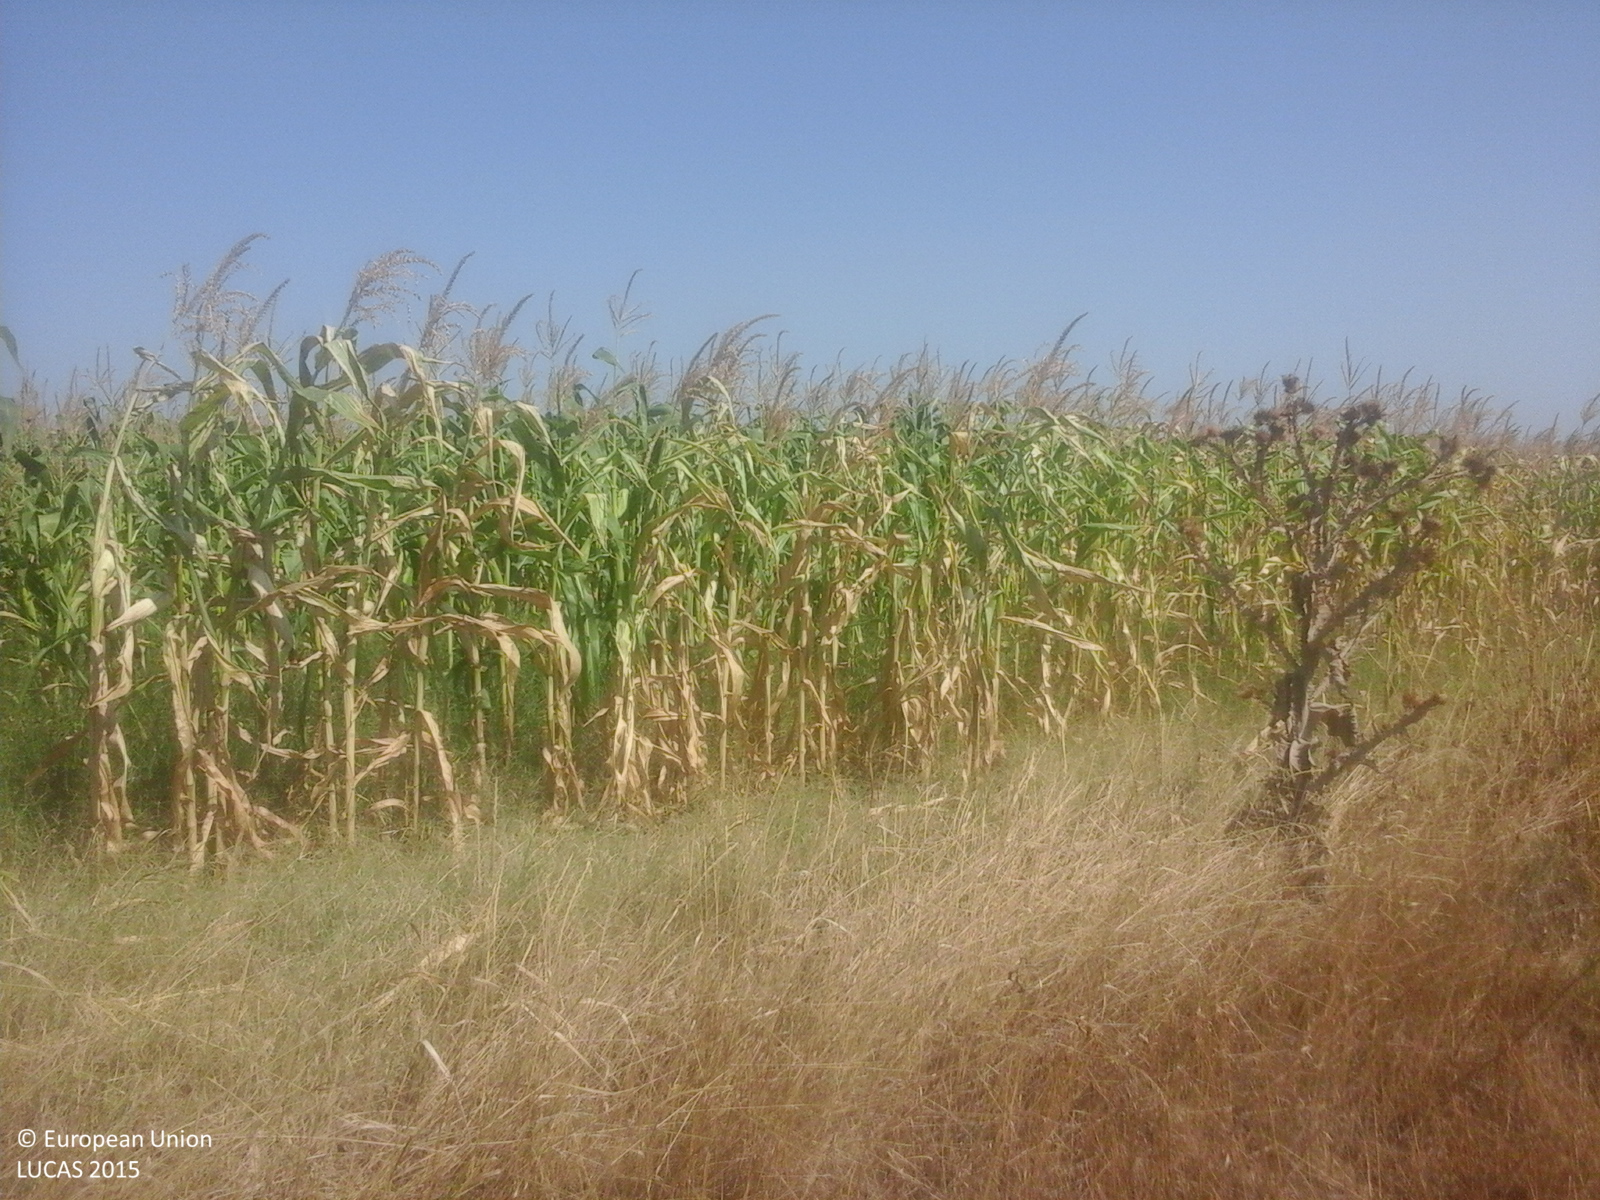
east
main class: Cropland
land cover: Maize
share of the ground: > 75 %
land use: Agriculture (excluding fallow land and kitchen gardens)
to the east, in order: Ditches and canals; Maize; Lucerne; Tracks; Lucerne; Maize; Spontaneously vegetated surfaces; Lucerne
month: August
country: RO
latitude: 45.0699
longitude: 26.8847
